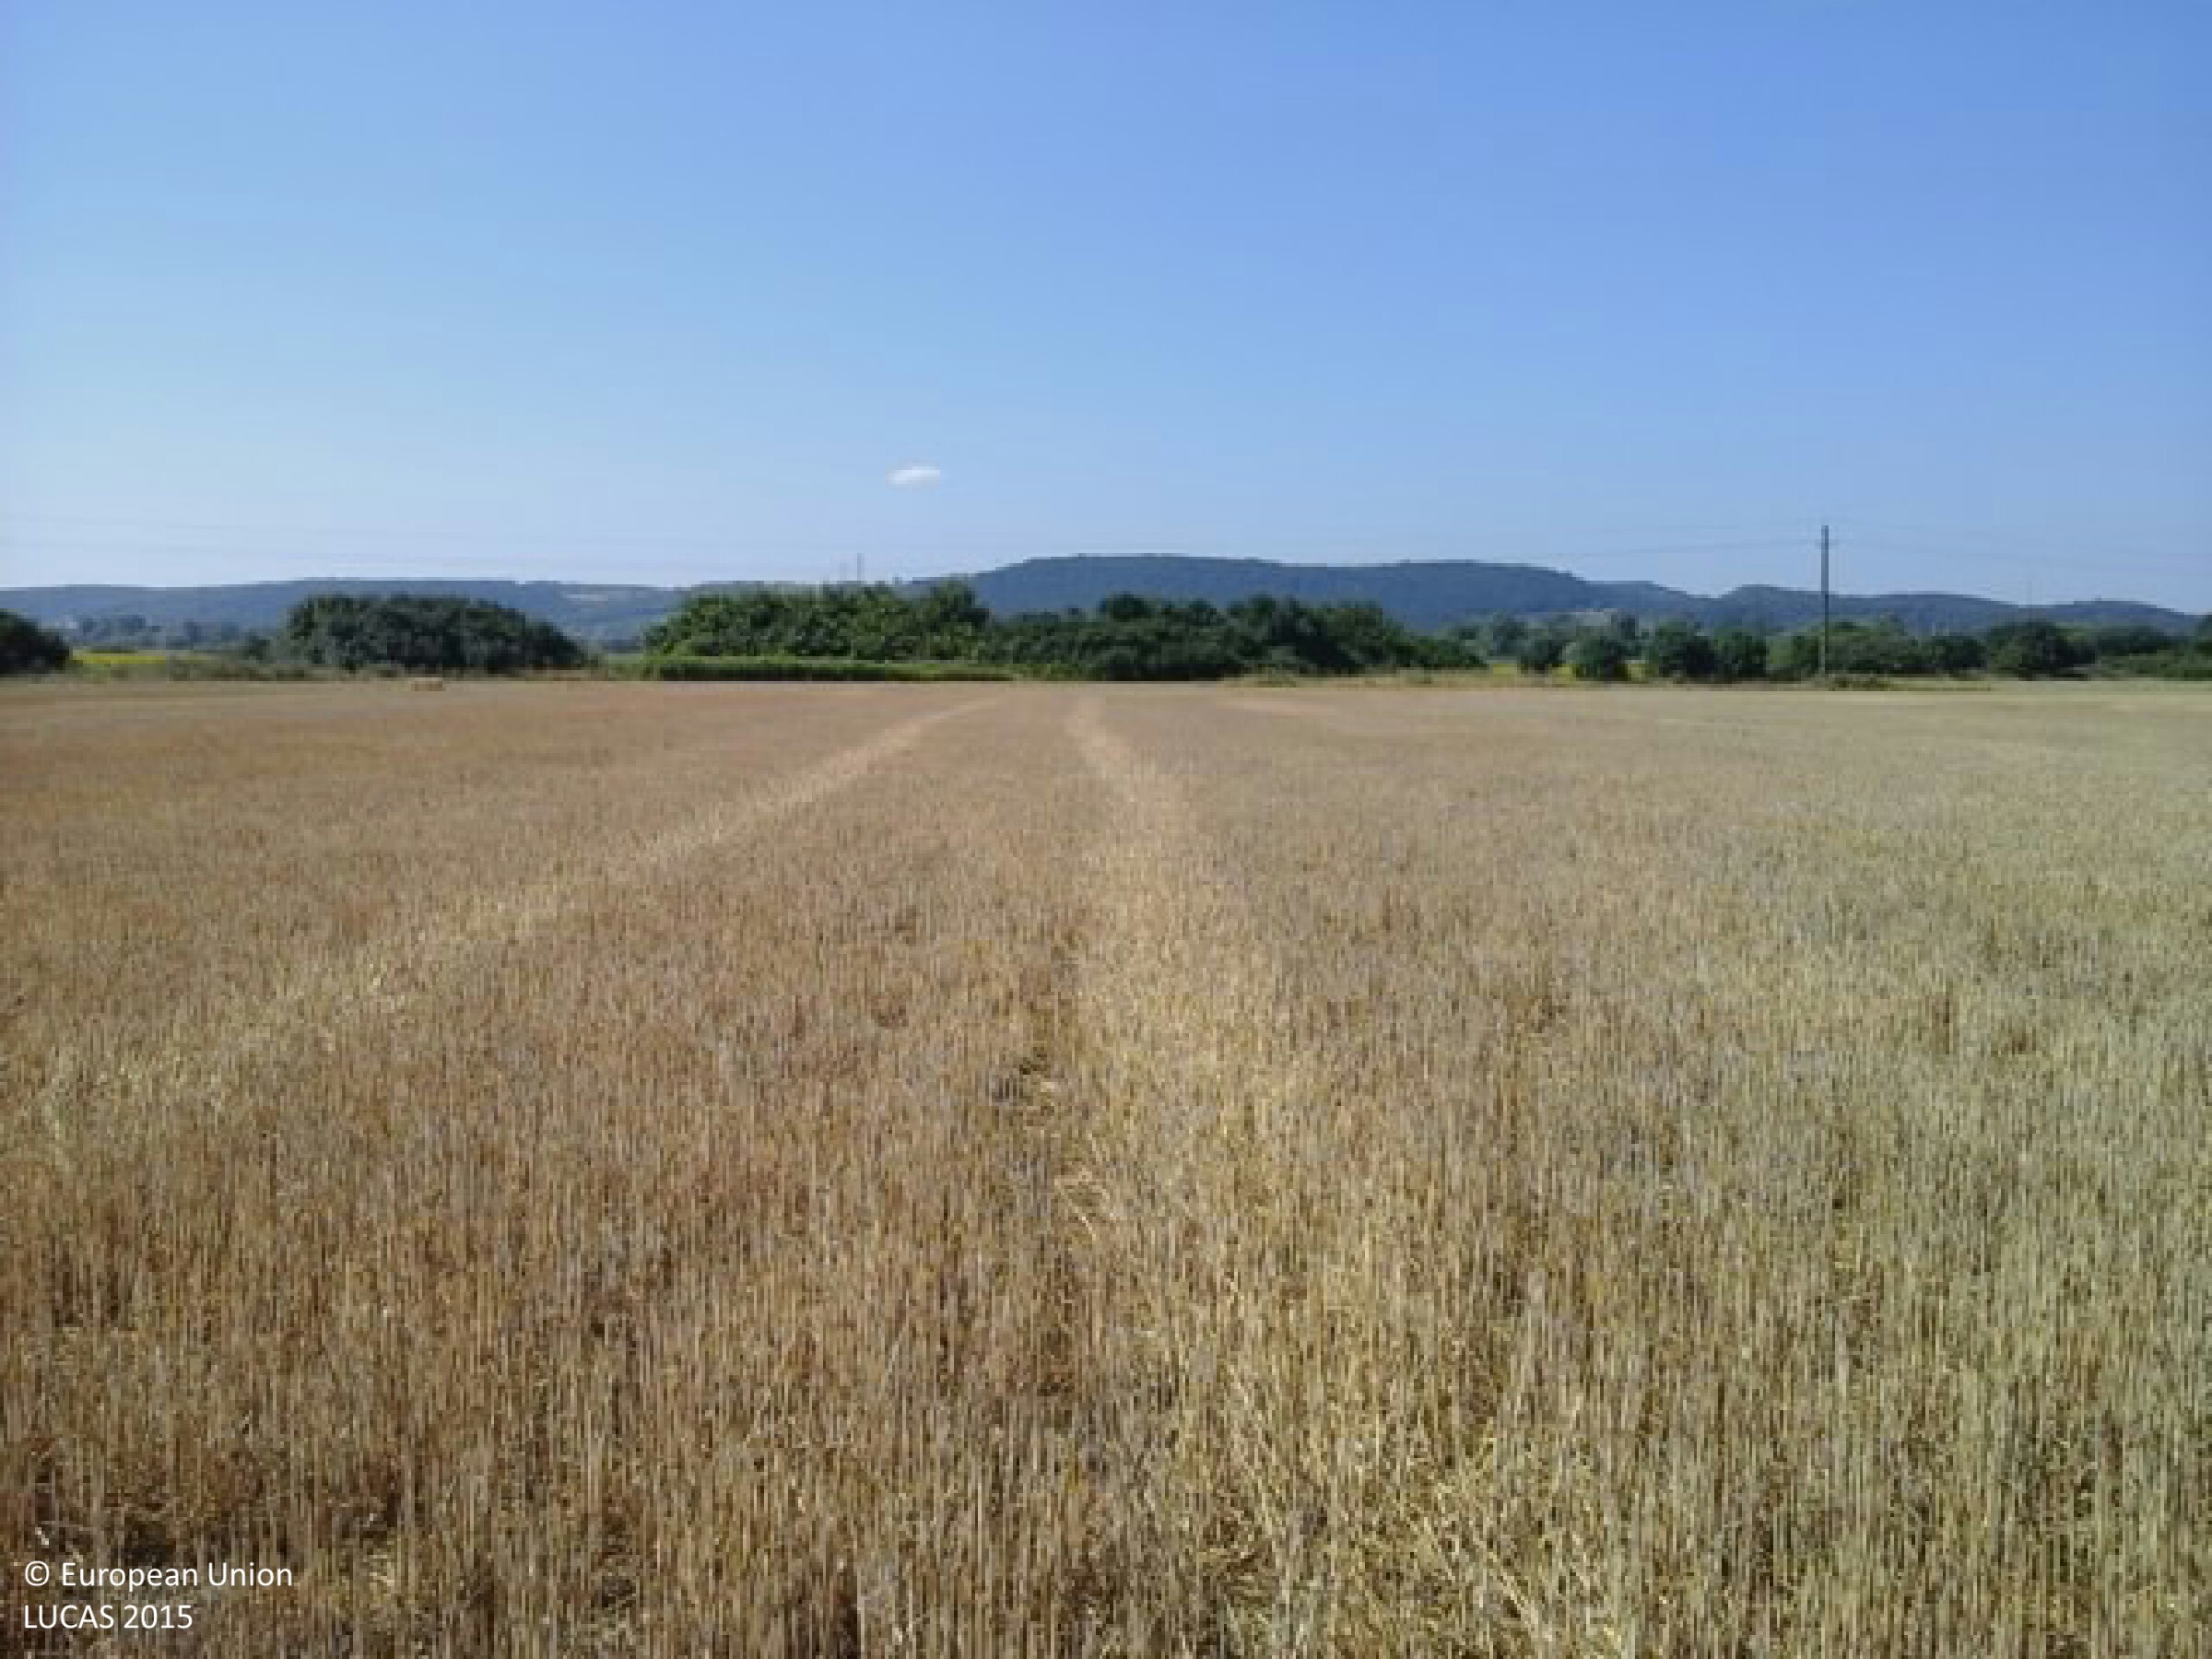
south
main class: Cropland
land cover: Common wheat
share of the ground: > 75 %
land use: Agriculture (excluding fallow land and kitchen gardens)
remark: Harvested field
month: July
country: HU
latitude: 48.2672
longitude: 20.6655
